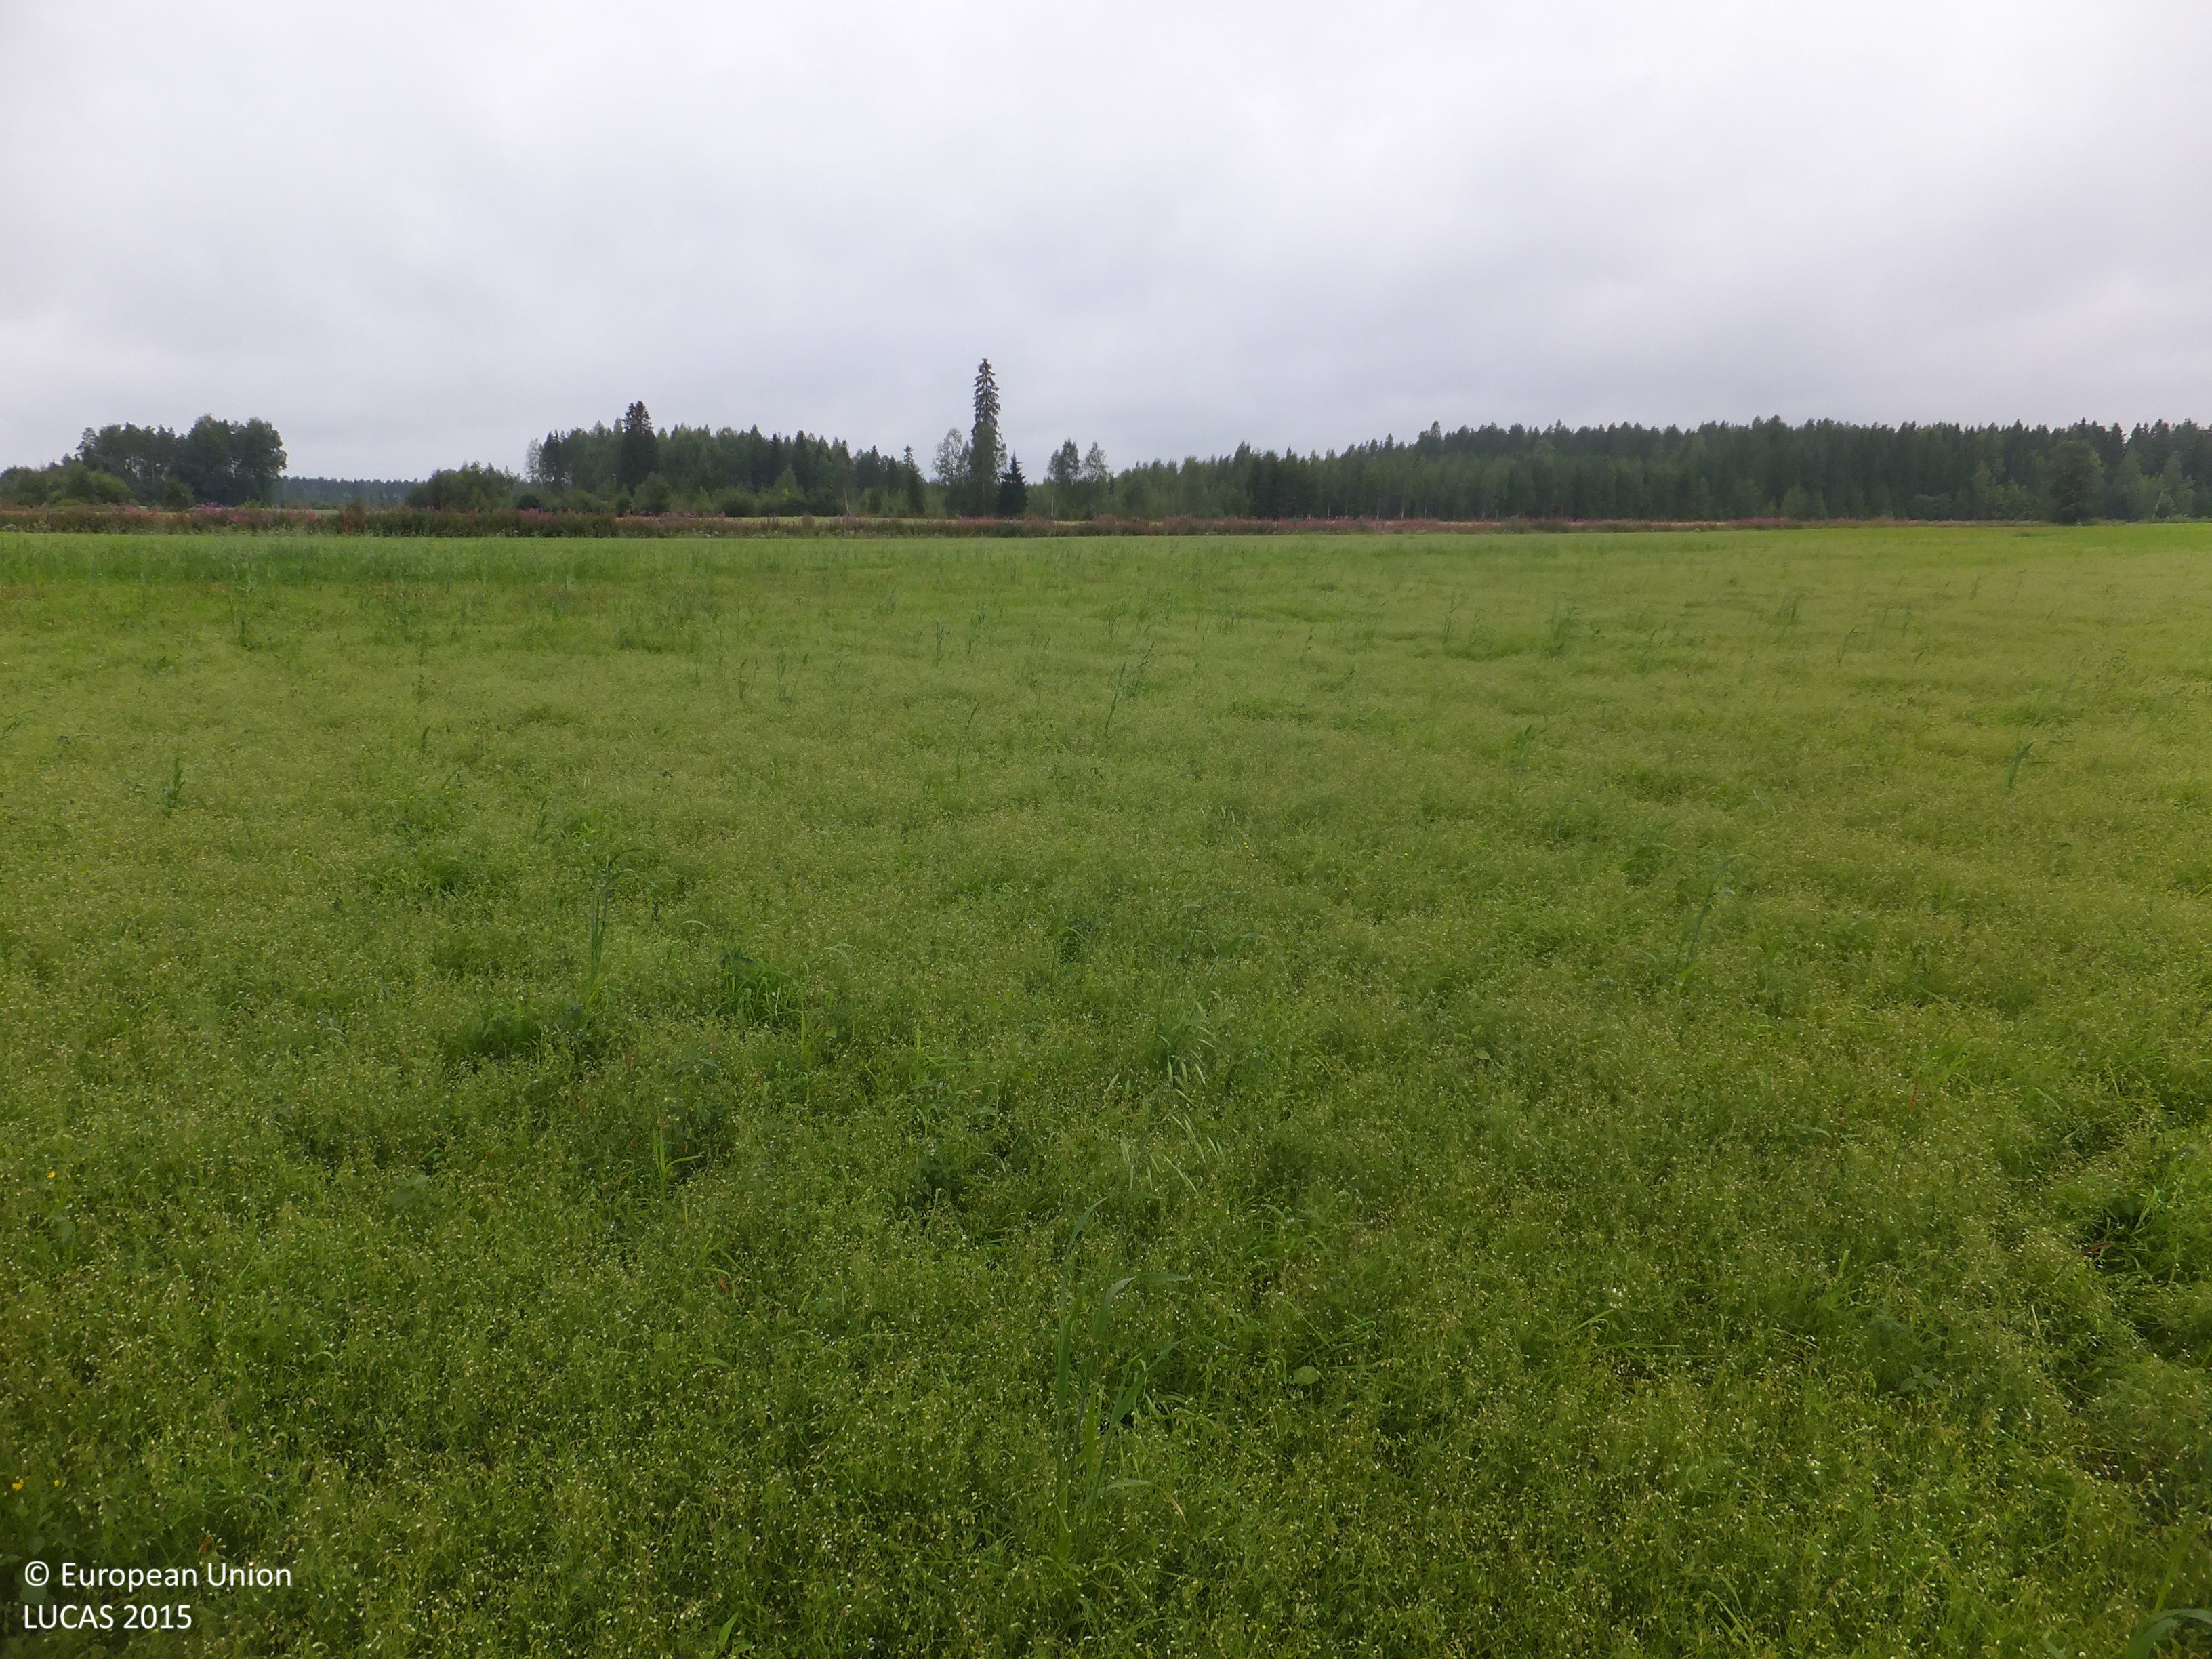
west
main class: Cropland
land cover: Temporary grasslands
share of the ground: > 75 %
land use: Agriculture (excluding fallow land and kitchen gardens)
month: August
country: FI
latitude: 63.3032
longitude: 23.0851
